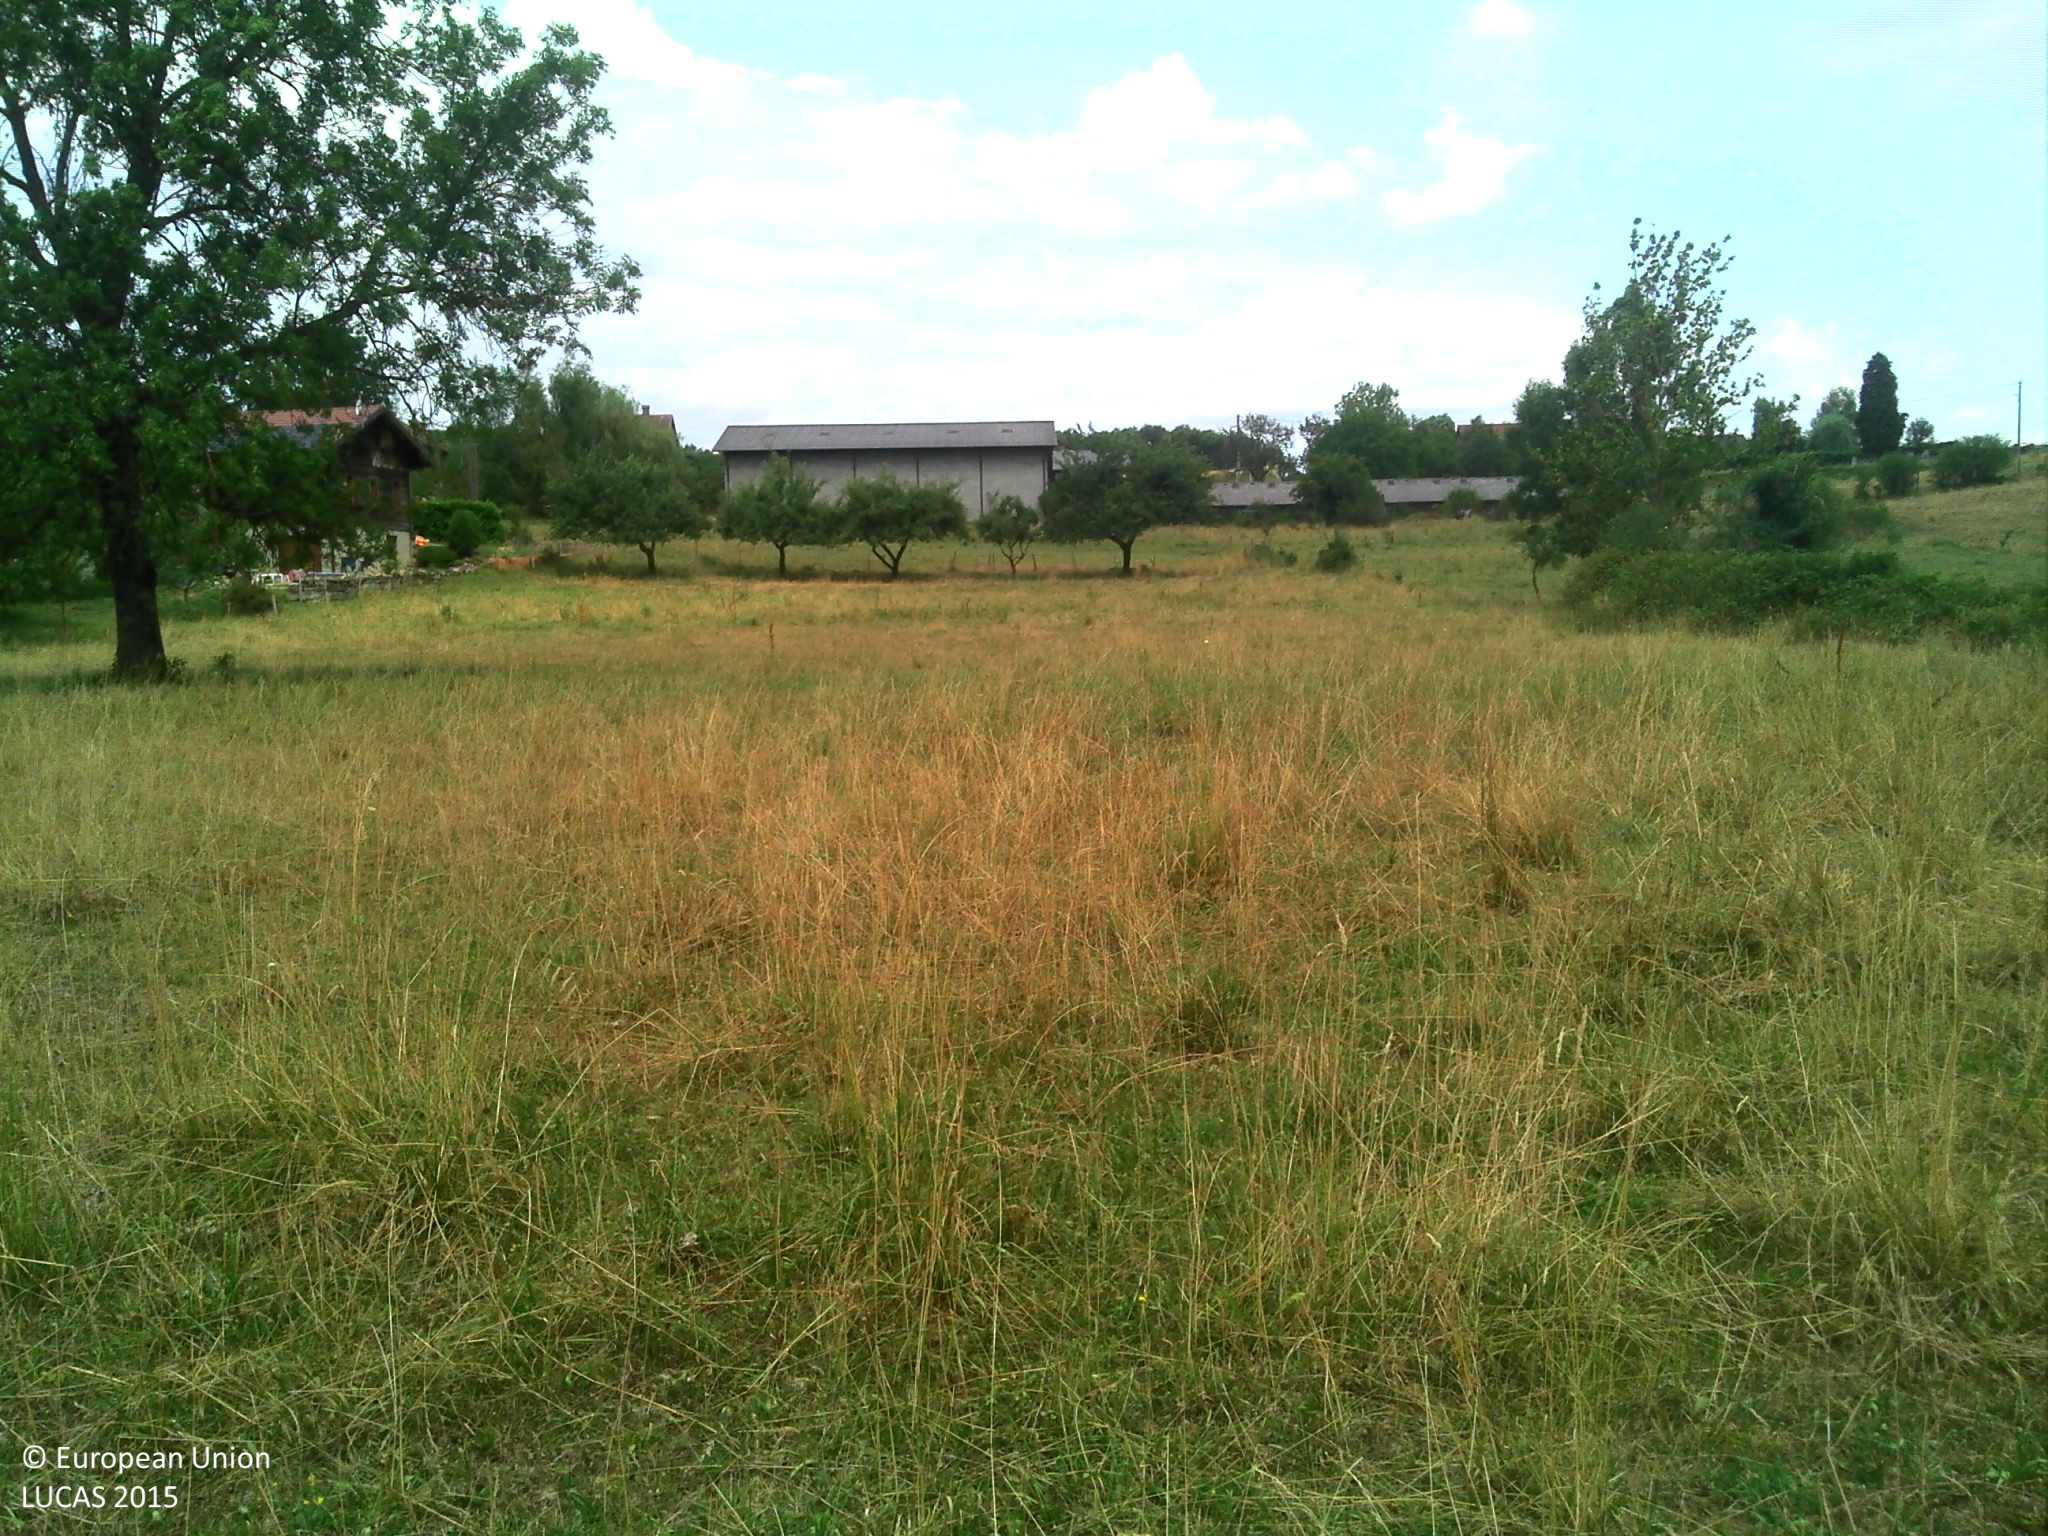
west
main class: Grassland
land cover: Grassland with sparse tree/shrub cover
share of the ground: > 75 %
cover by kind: herbaceous plants 95 %, broadleaved forest trees 5 %
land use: Agriculture (excluding fallow land and kitchen gardens)
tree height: > 5 m
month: July
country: FR
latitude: 46.2145
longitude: 6.2832
